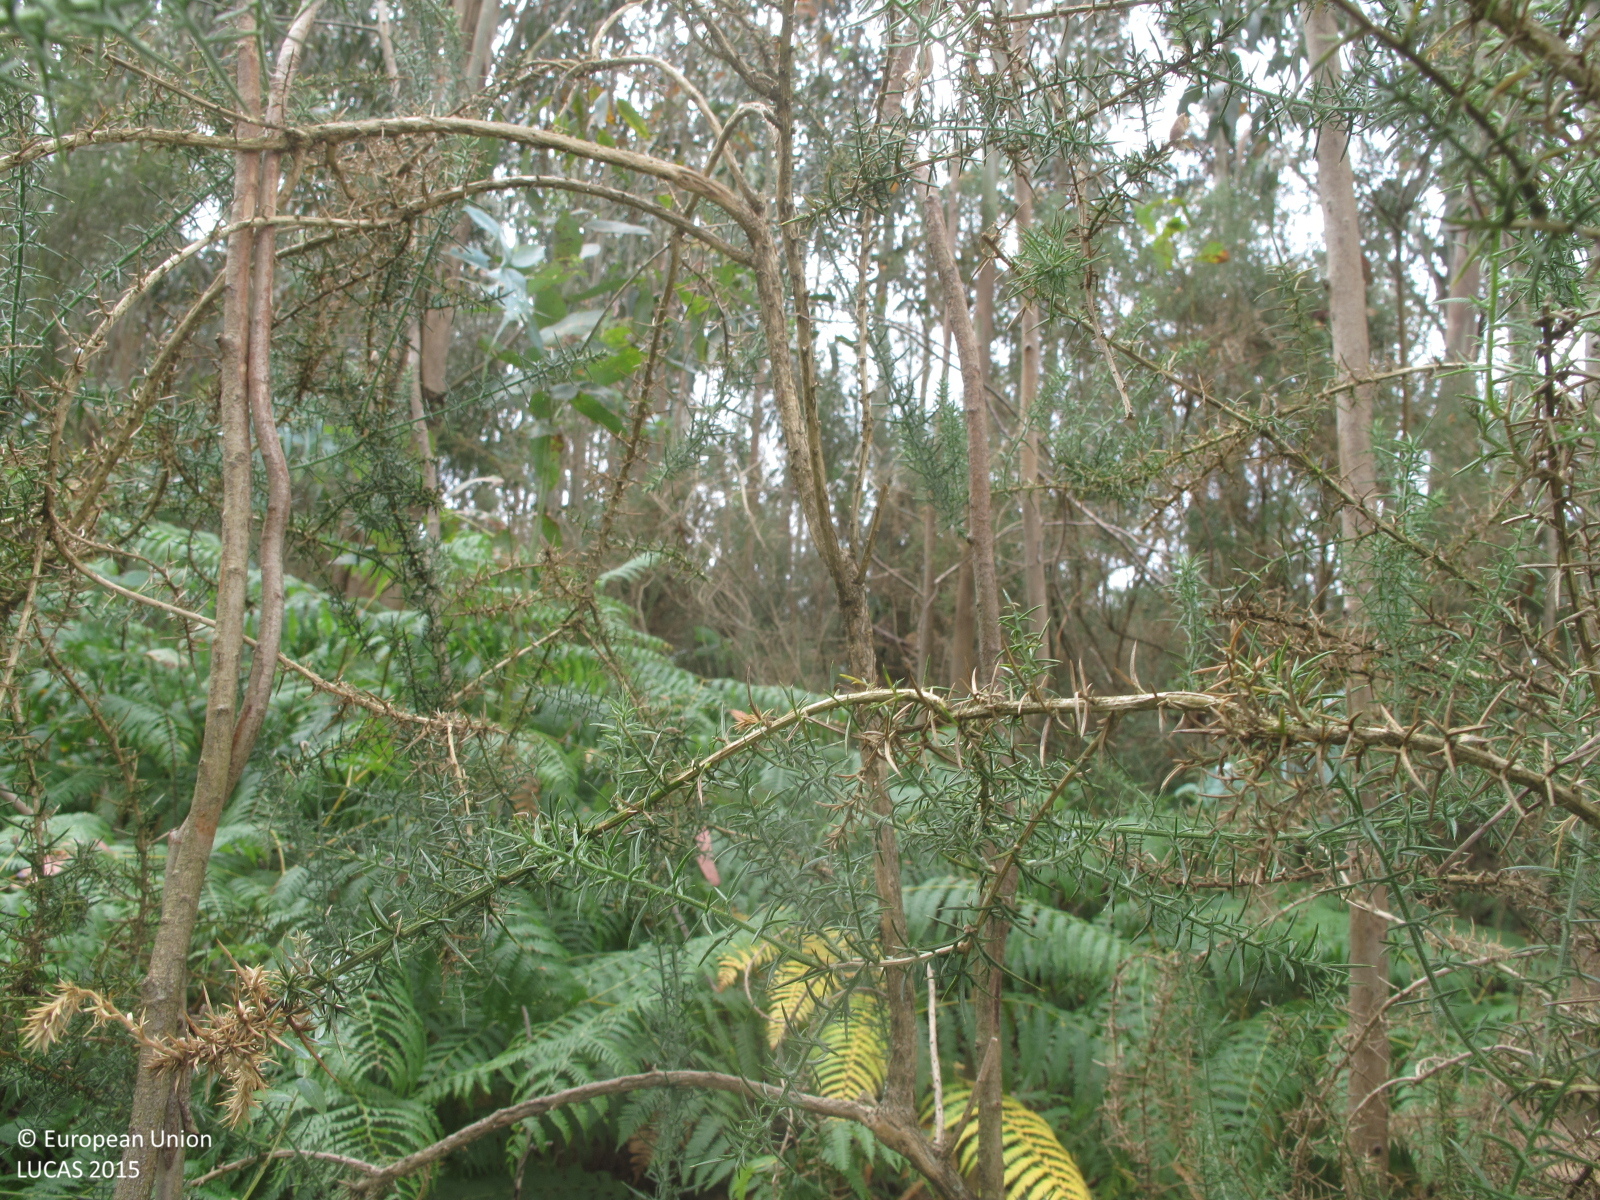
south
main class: Woodland
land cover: Broadleaved woodland
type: exotic forest
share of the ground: 50 - 75 %
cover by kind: broadleaved forest trees 60 %, shrubs 20 %, herbaceous plants 20 %
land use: Forestry
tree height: > 5 m
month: July
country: ES
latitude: 43.5306
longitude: -8.1289
